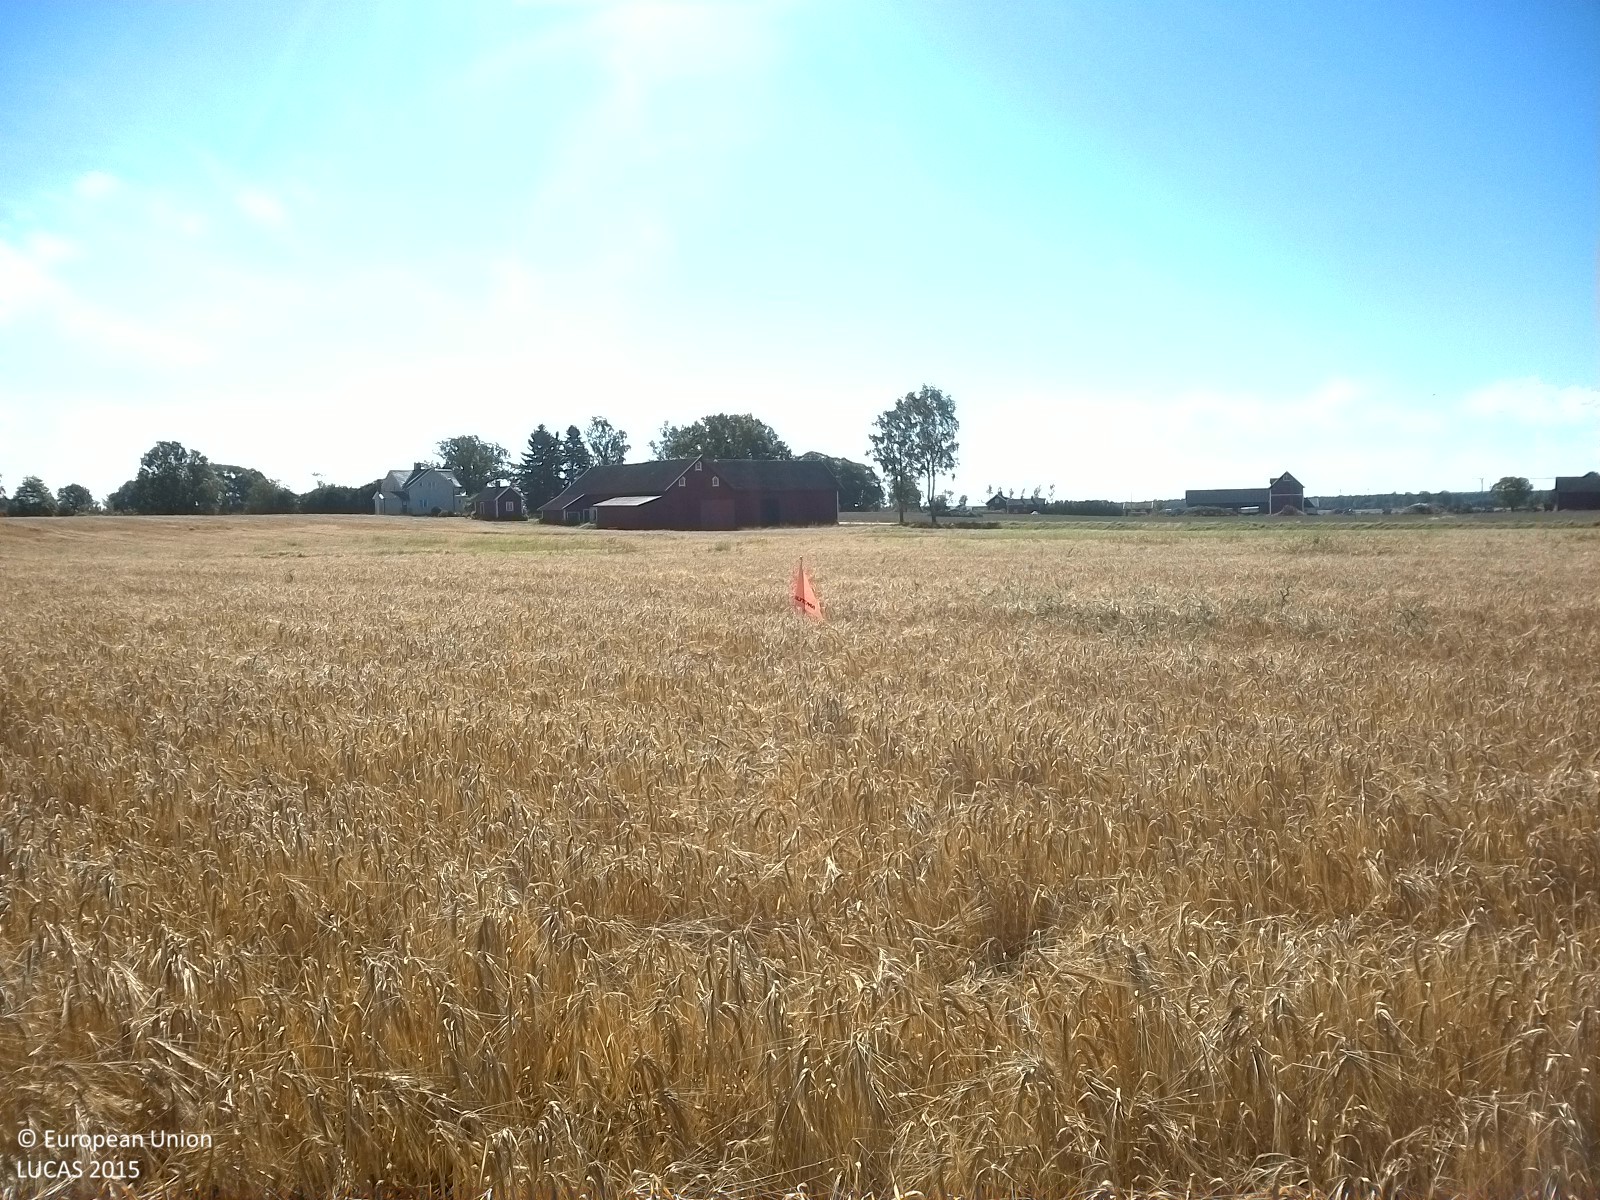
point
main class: Cropland
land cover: Barley
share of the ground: > 75 %
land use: Agriculture (excluding fallow land and kitchen gardens)
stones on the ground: < 10 %
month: August
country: SE
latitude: 59.2055
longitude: 15.5434
